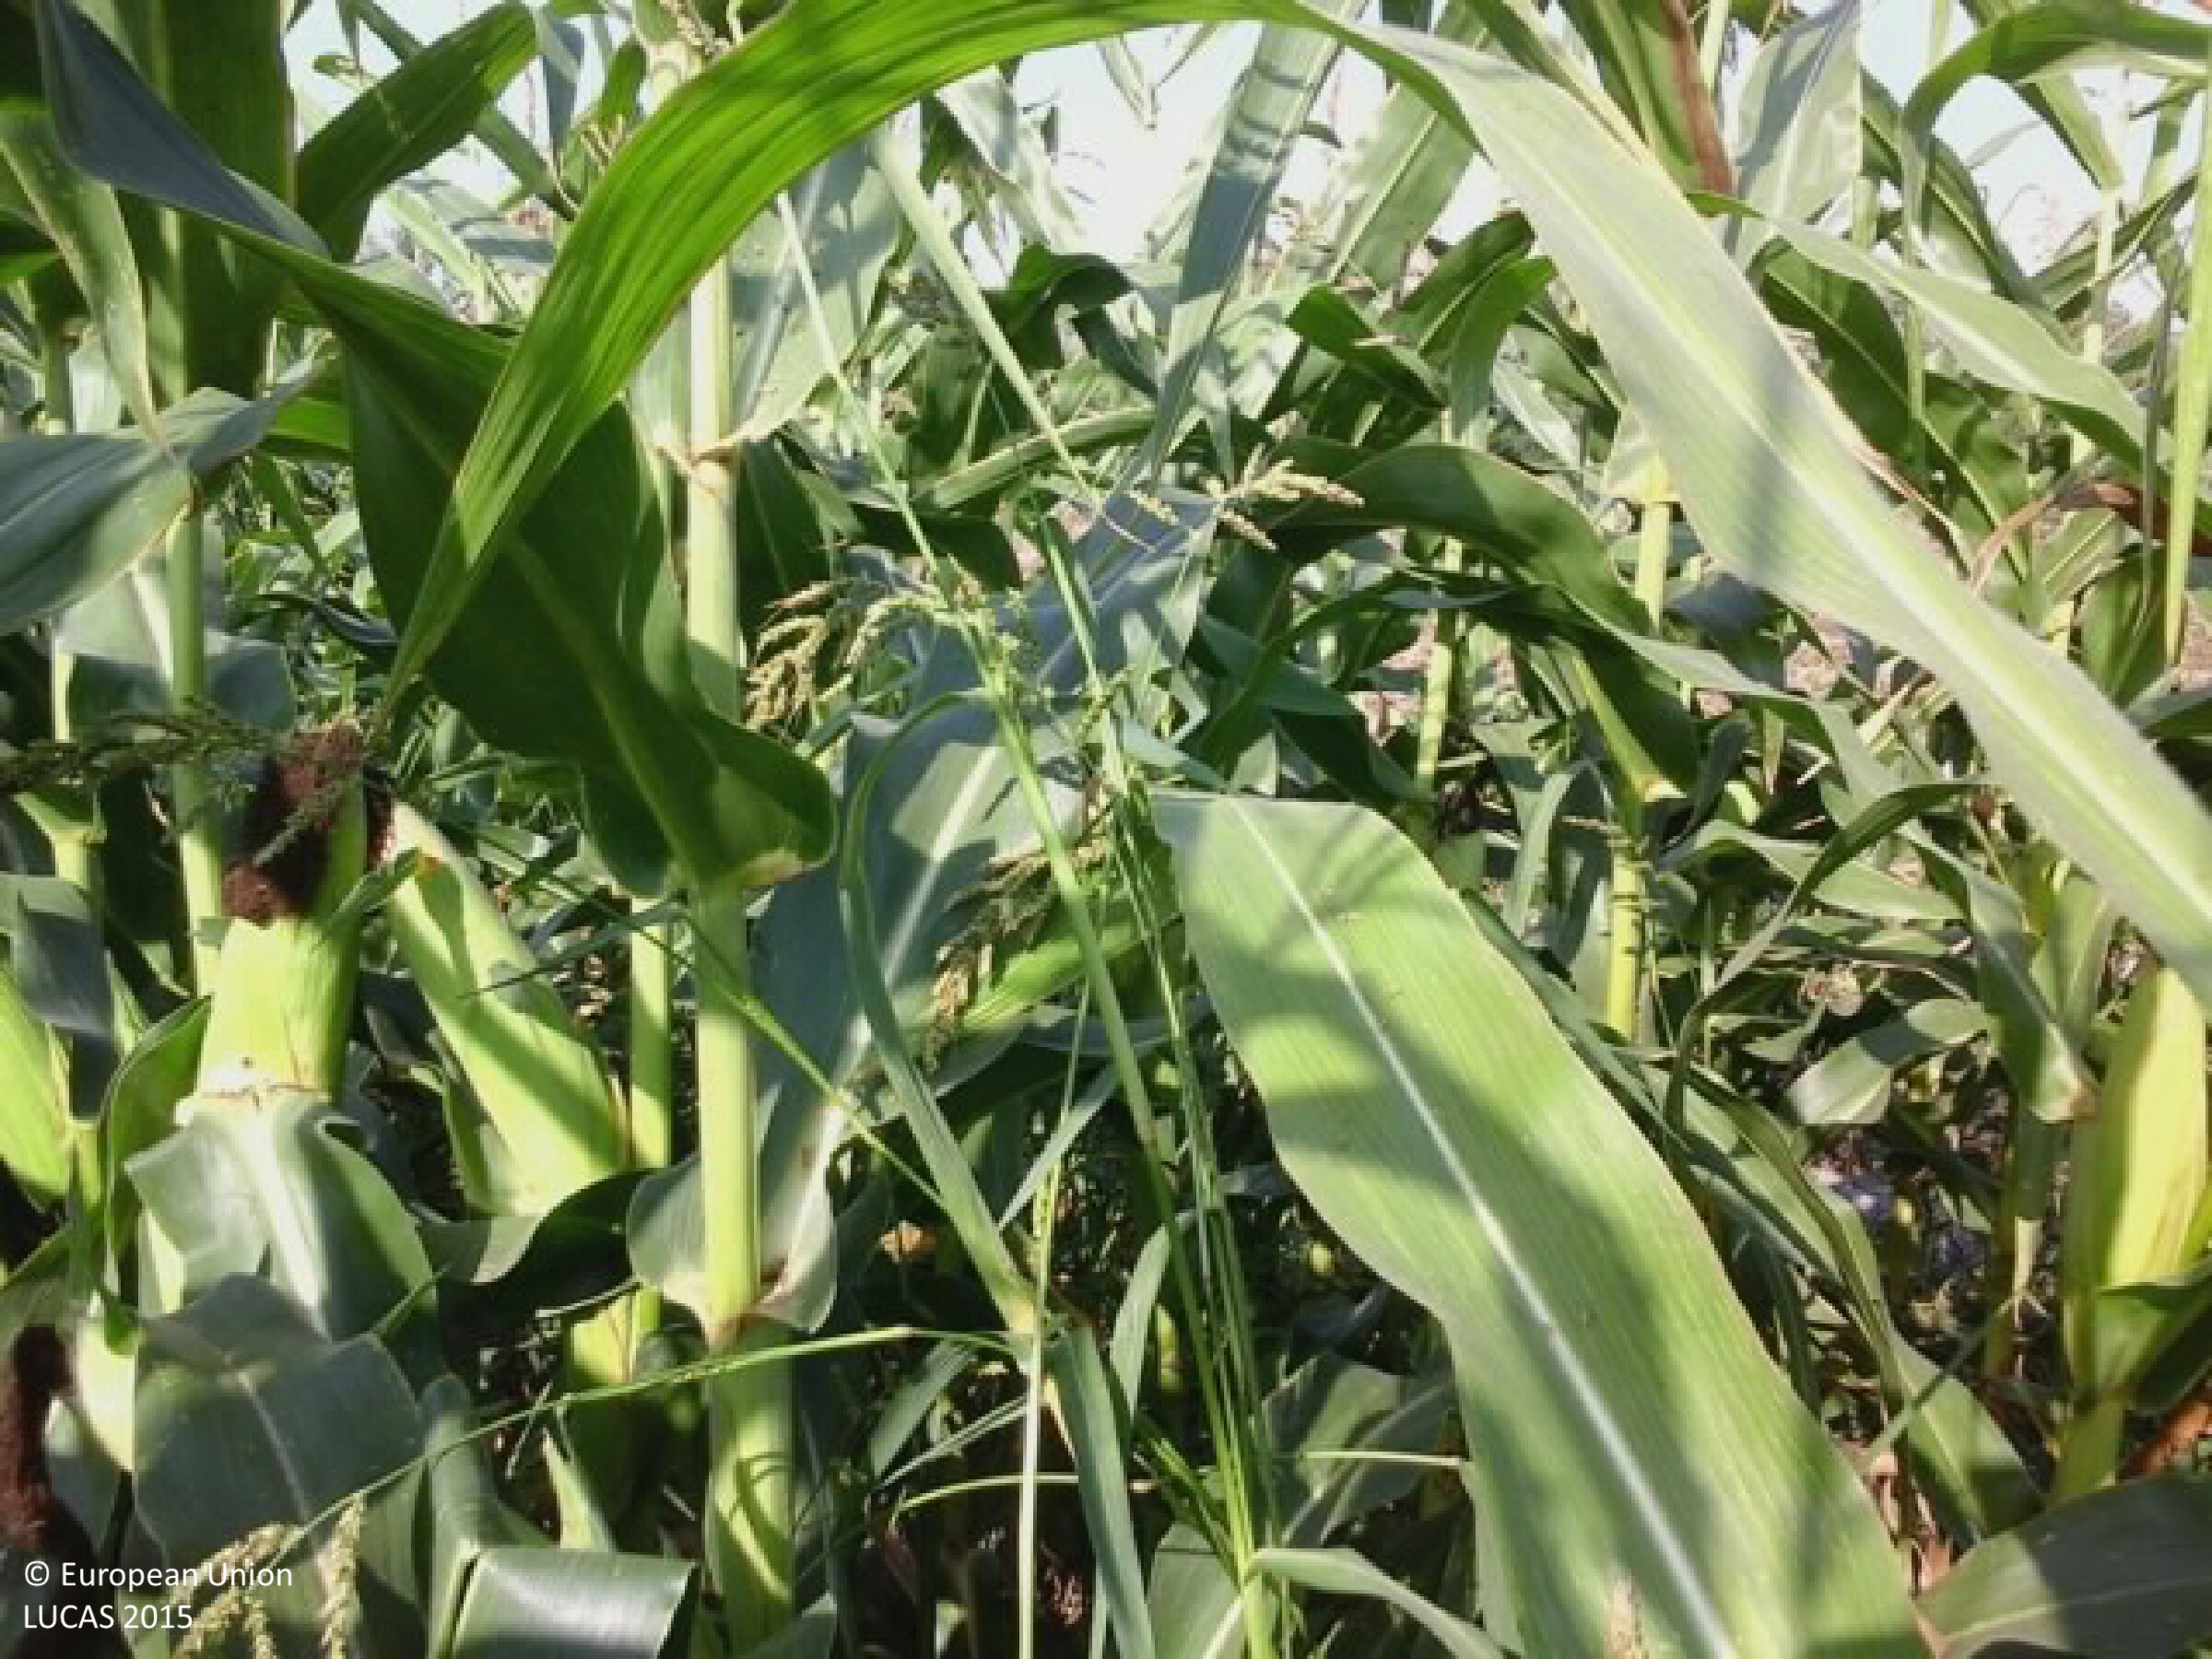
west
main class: Cropland
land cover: Maize
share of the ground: > 75 %
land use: Agriculture (excluding fallow land and kitchen gardens)
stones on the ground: < 10 %
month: August
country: HU
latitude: 47.3007
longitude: 19.1300
